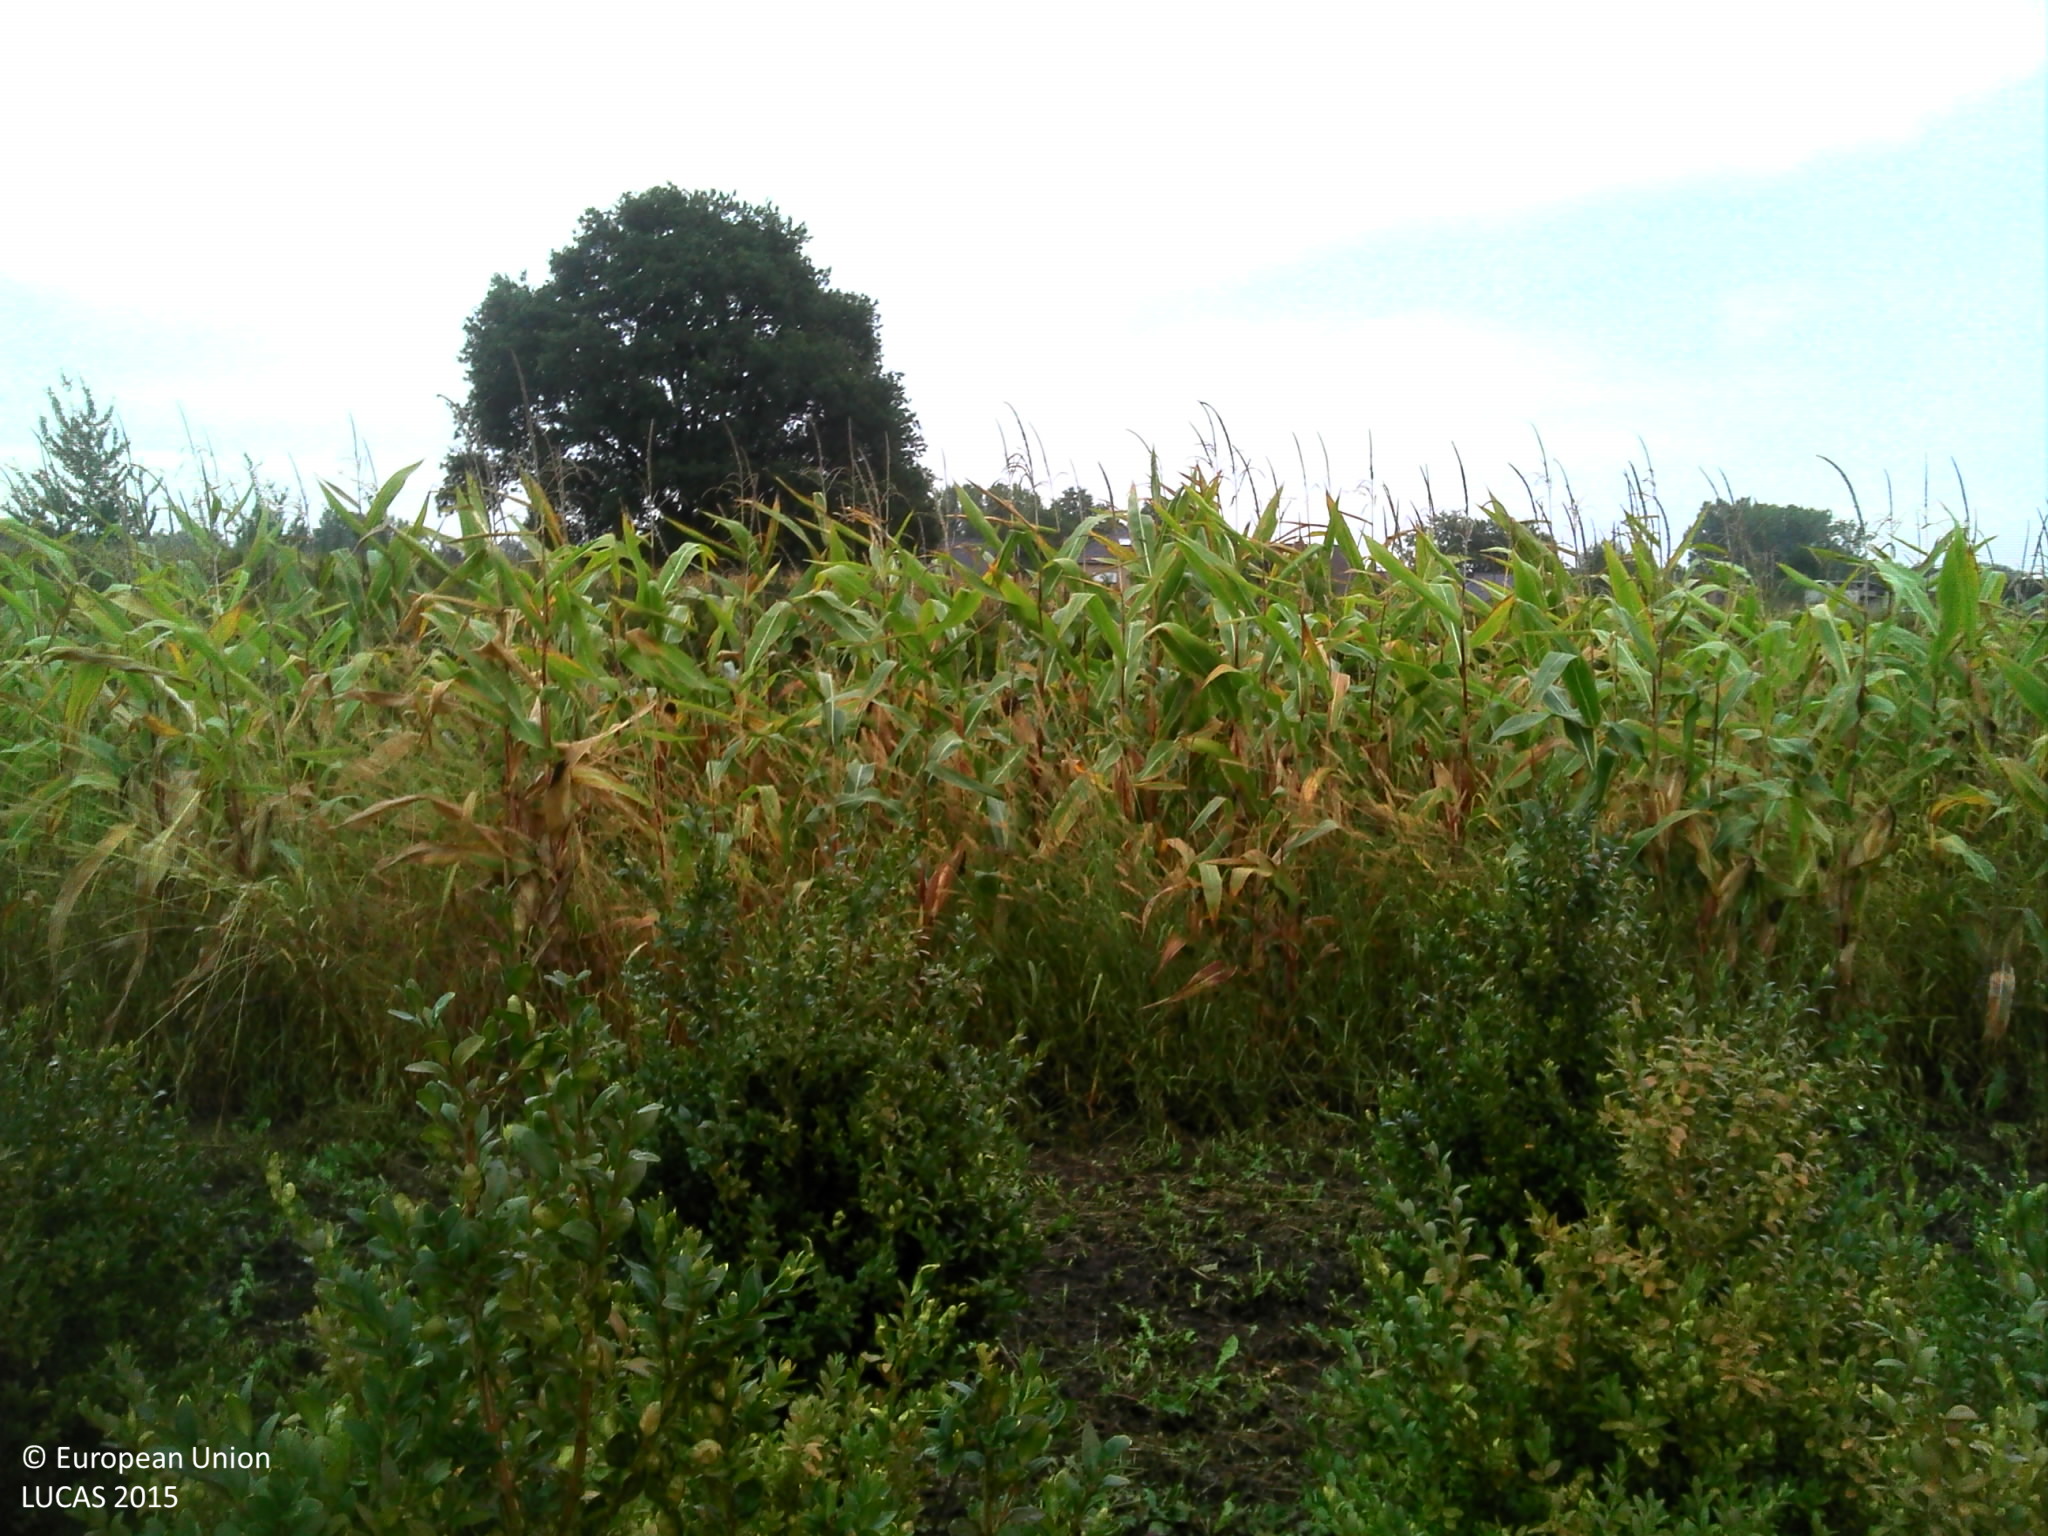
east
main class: Cropland
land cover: Nurseries
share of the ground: > 75 %
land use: Agriculture (excluding fallow land and kitchen gardens)
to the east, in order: Nurseries; Maize; Nurseries; Maize; Single bushes/trees; Grass margins; Fences; Grassland without tree/shrub cover; Artificial constructions in urban areas; Broadleaved woodland
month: October
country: BE
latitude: 51.1099
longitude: 4.7830
